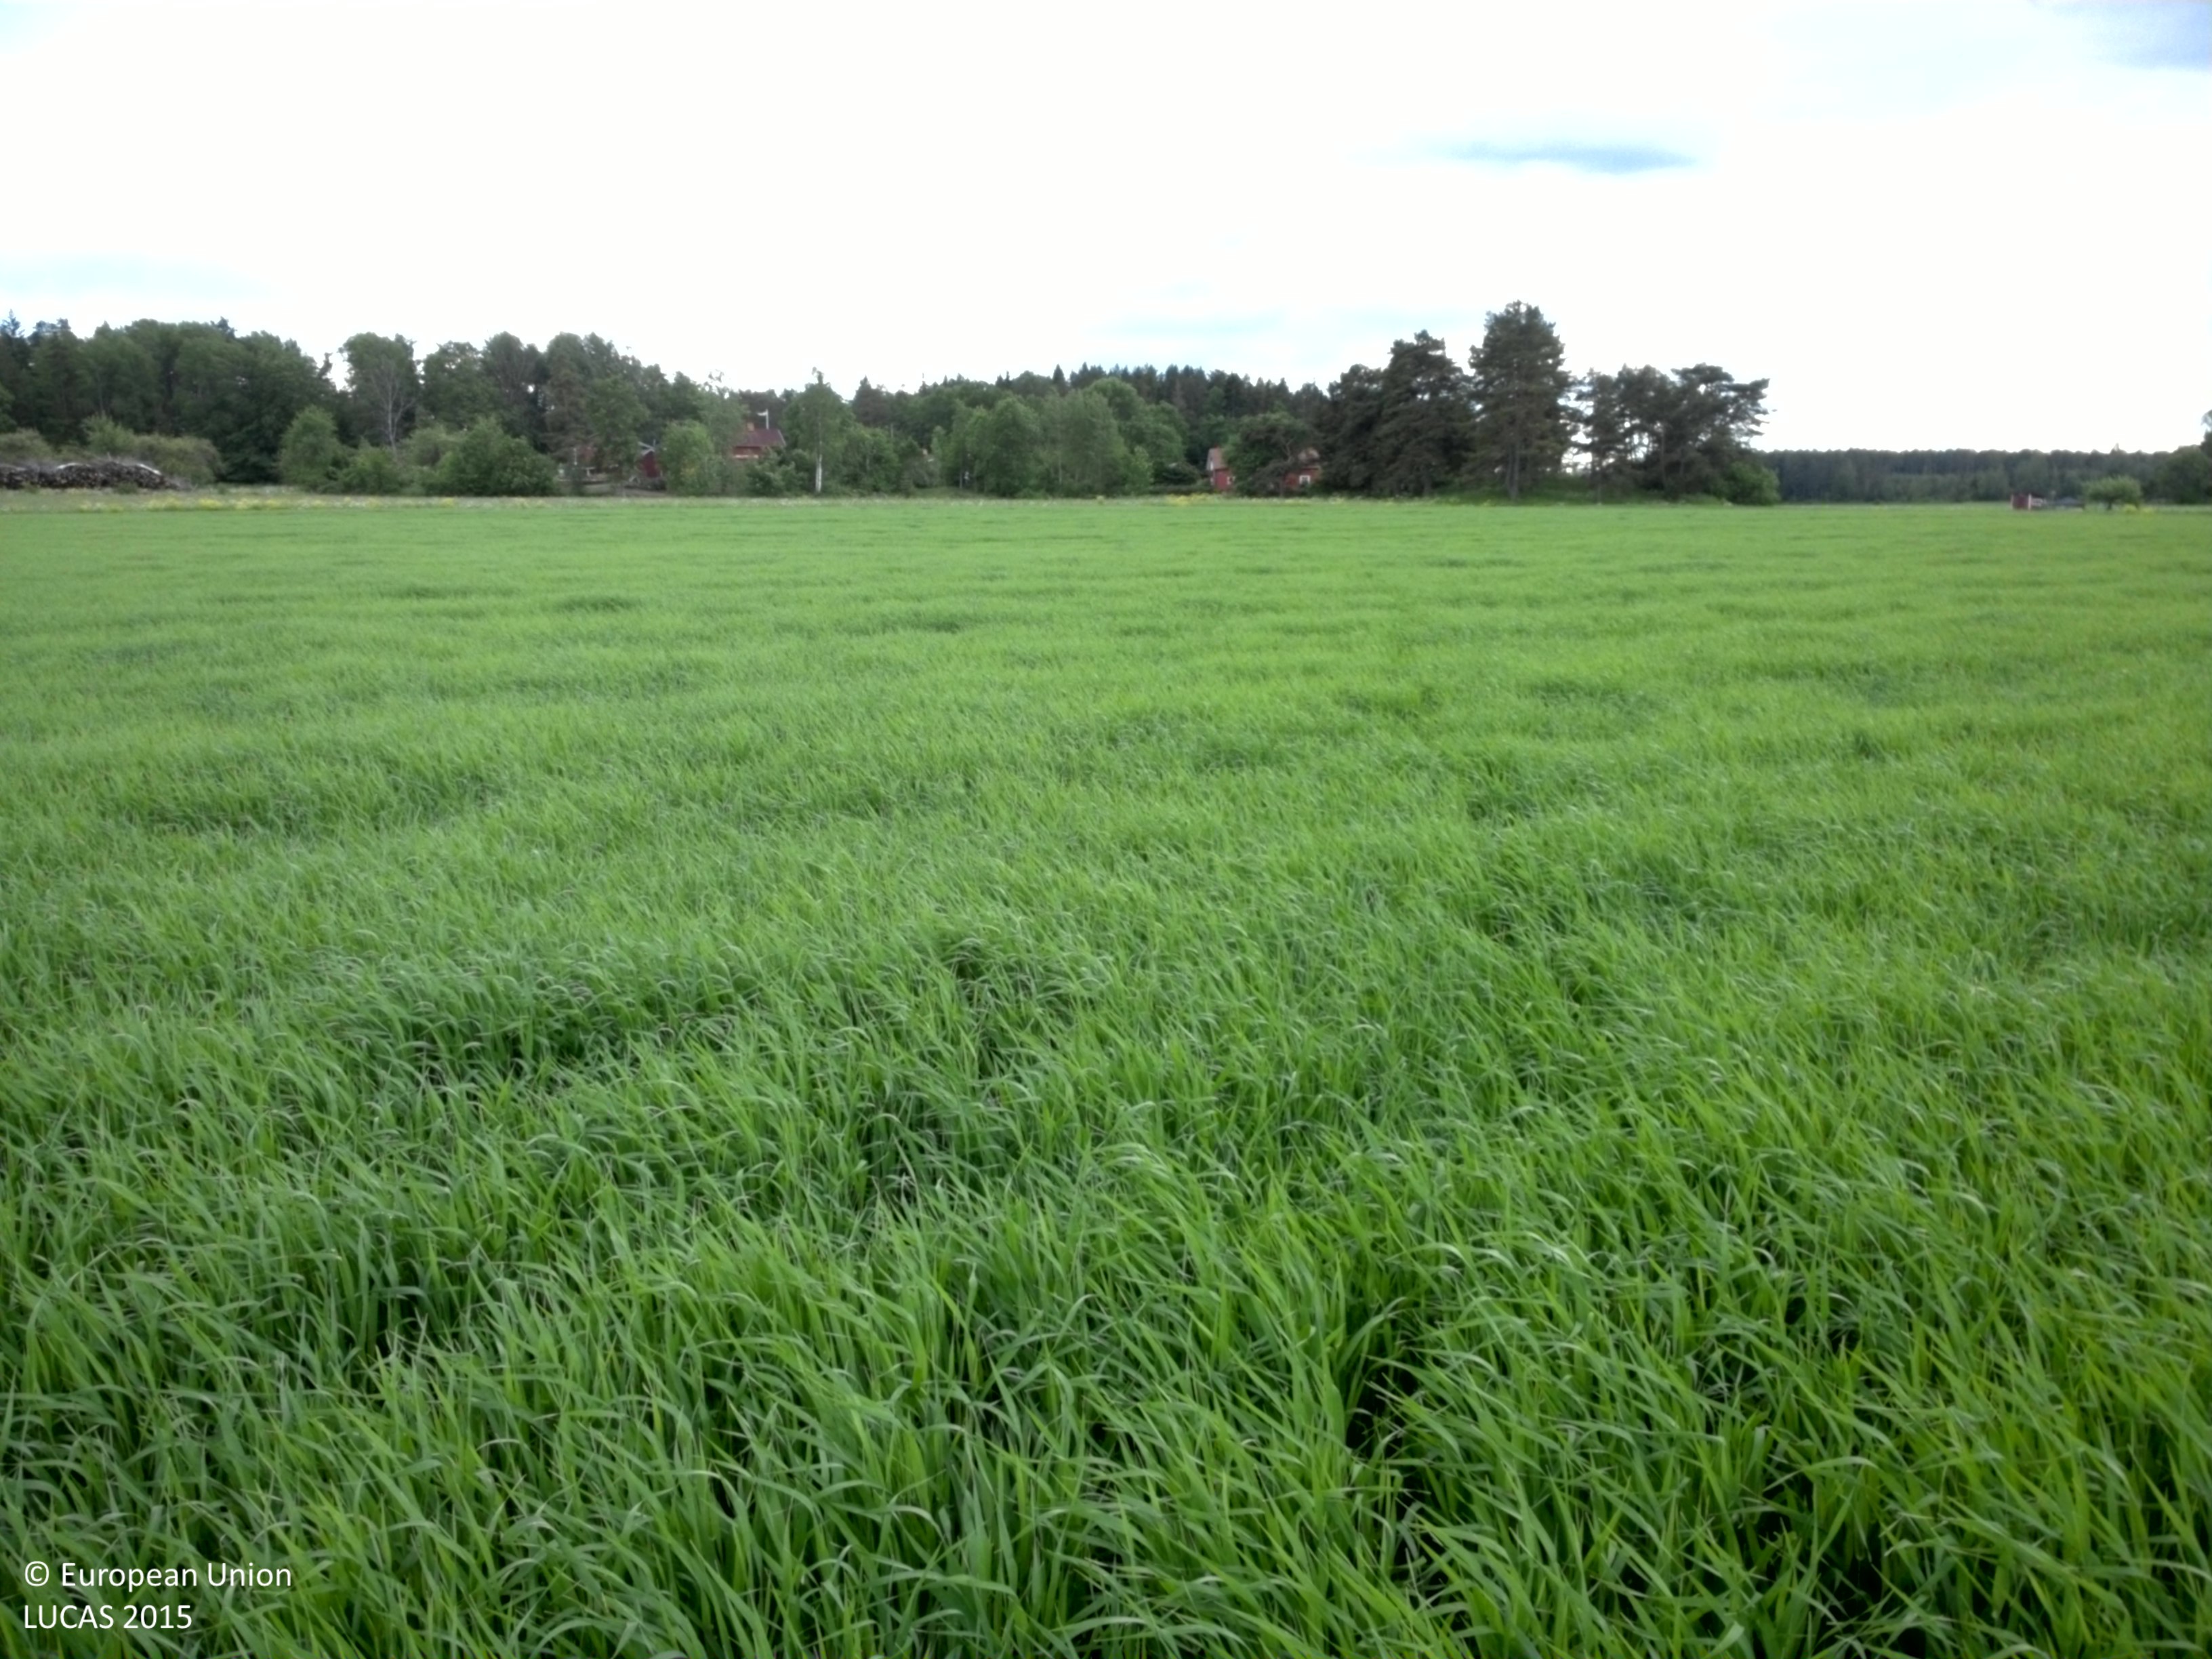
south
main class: Cropland
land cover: Barley
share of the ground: 25 - 50 %
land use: Agriculture (excluding fallow land and kitchen gardens)
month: June
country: SE
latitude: 59.9094
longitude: 17.4858
